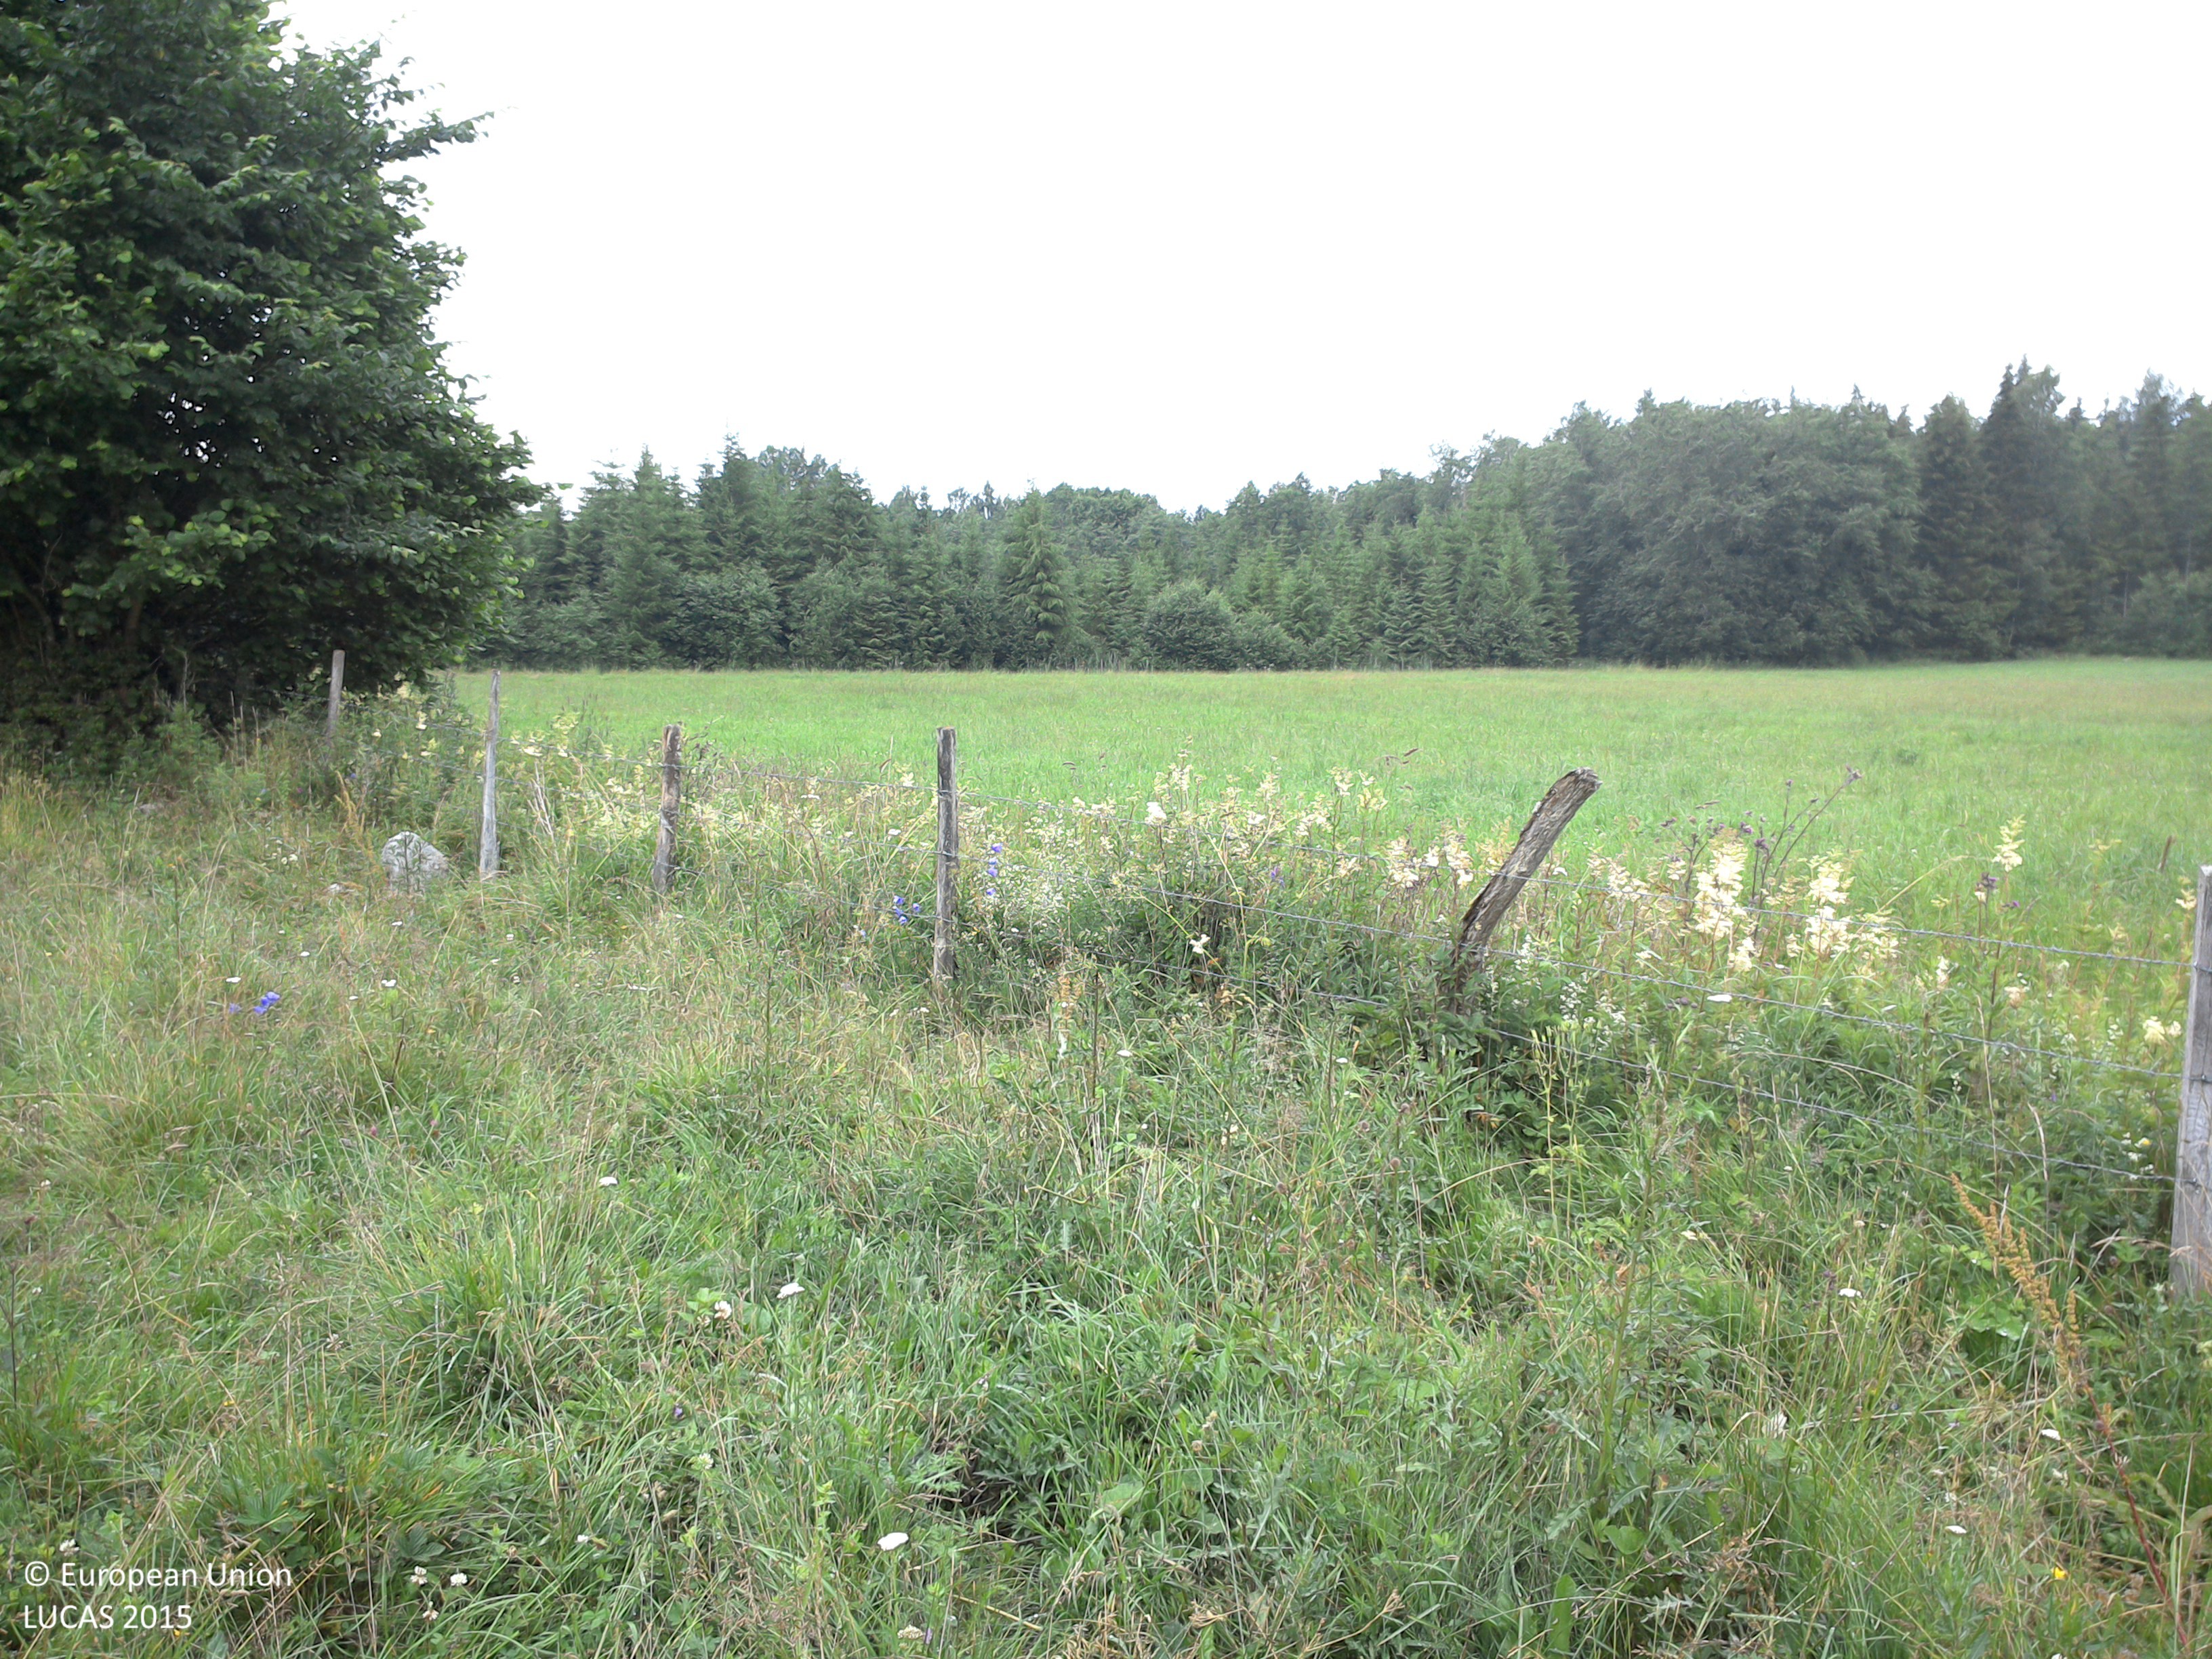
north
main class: Grassland
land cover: Grassland without tree/shrub cover
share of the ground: > 75 %
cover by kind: herbaceous plants 100 %
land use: Agriculture (excluding fallow land and kitchen gardens)
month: July
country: SE
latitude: 58.2903
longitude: 14.9580
